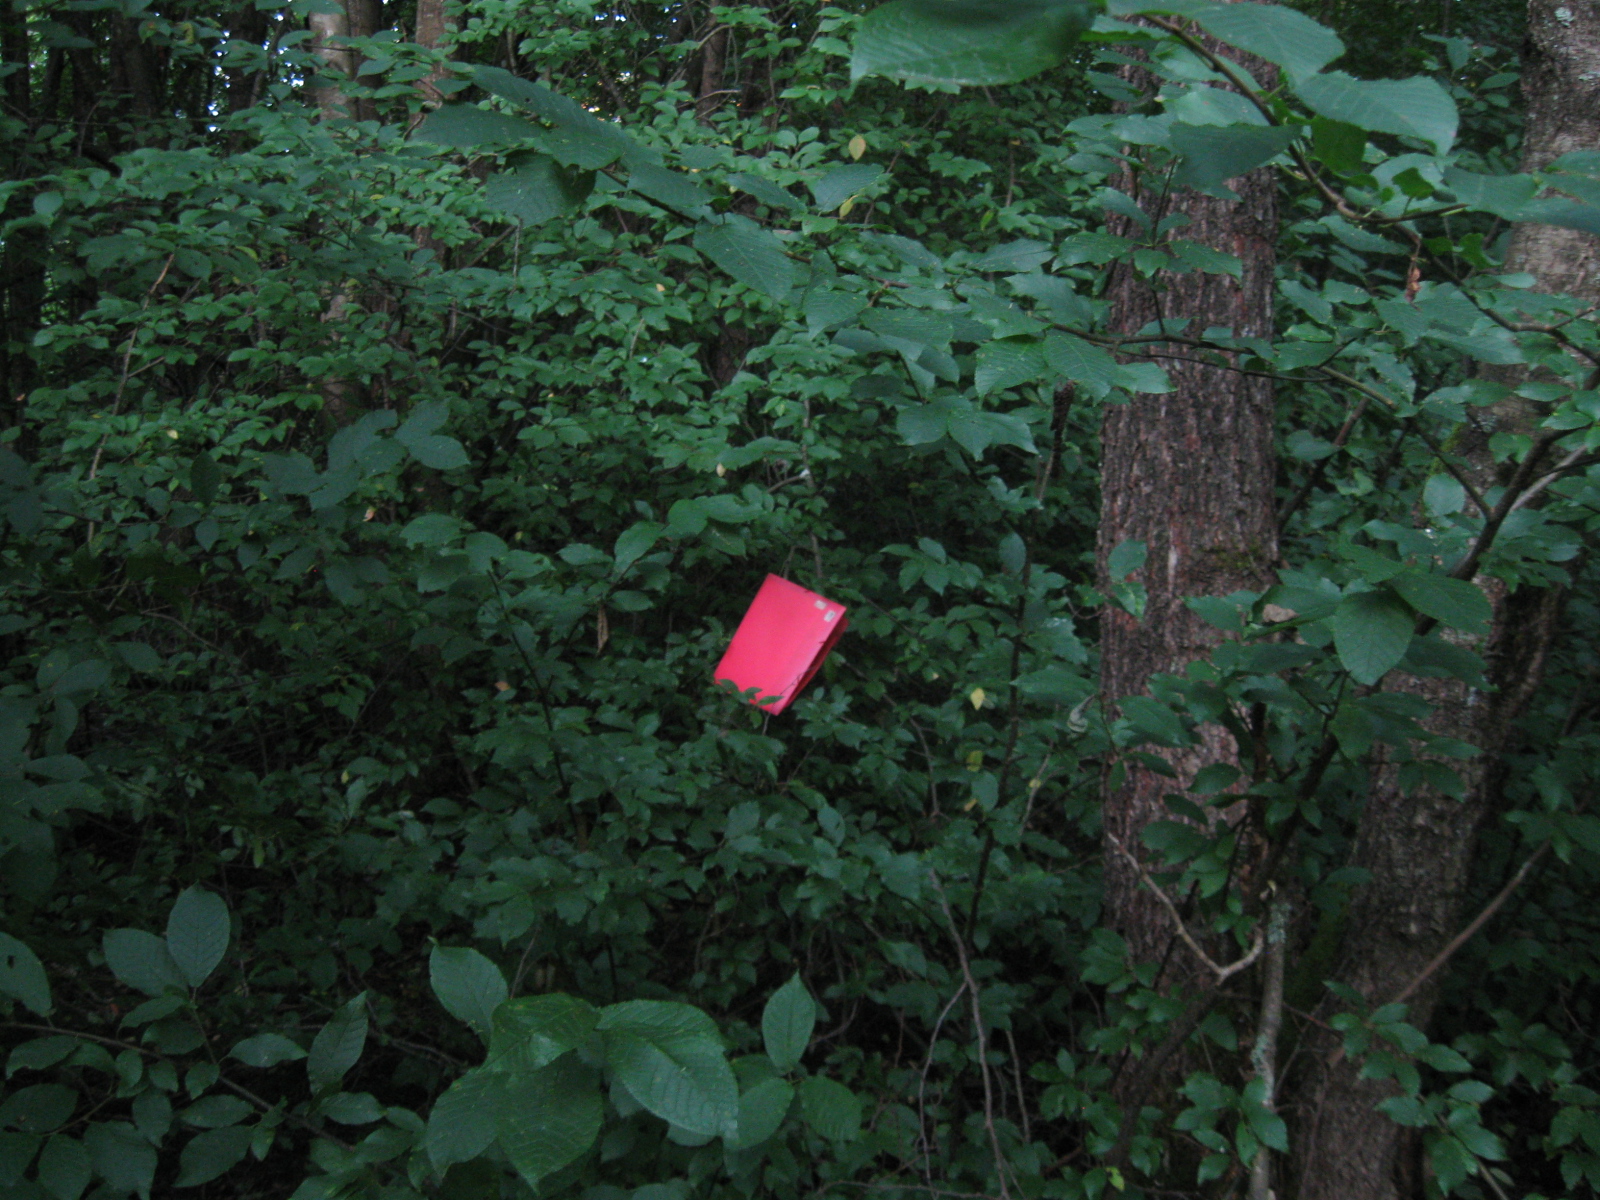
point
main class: Woodland
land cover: Broadleaved woodland
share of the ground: > 75 %
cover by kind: broadleaved forest trees 90 %, shrubs 5 %, herbaceous plants 5 %
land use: Forestry
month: July
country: LT
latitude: 54.3847
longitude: 24.3744
